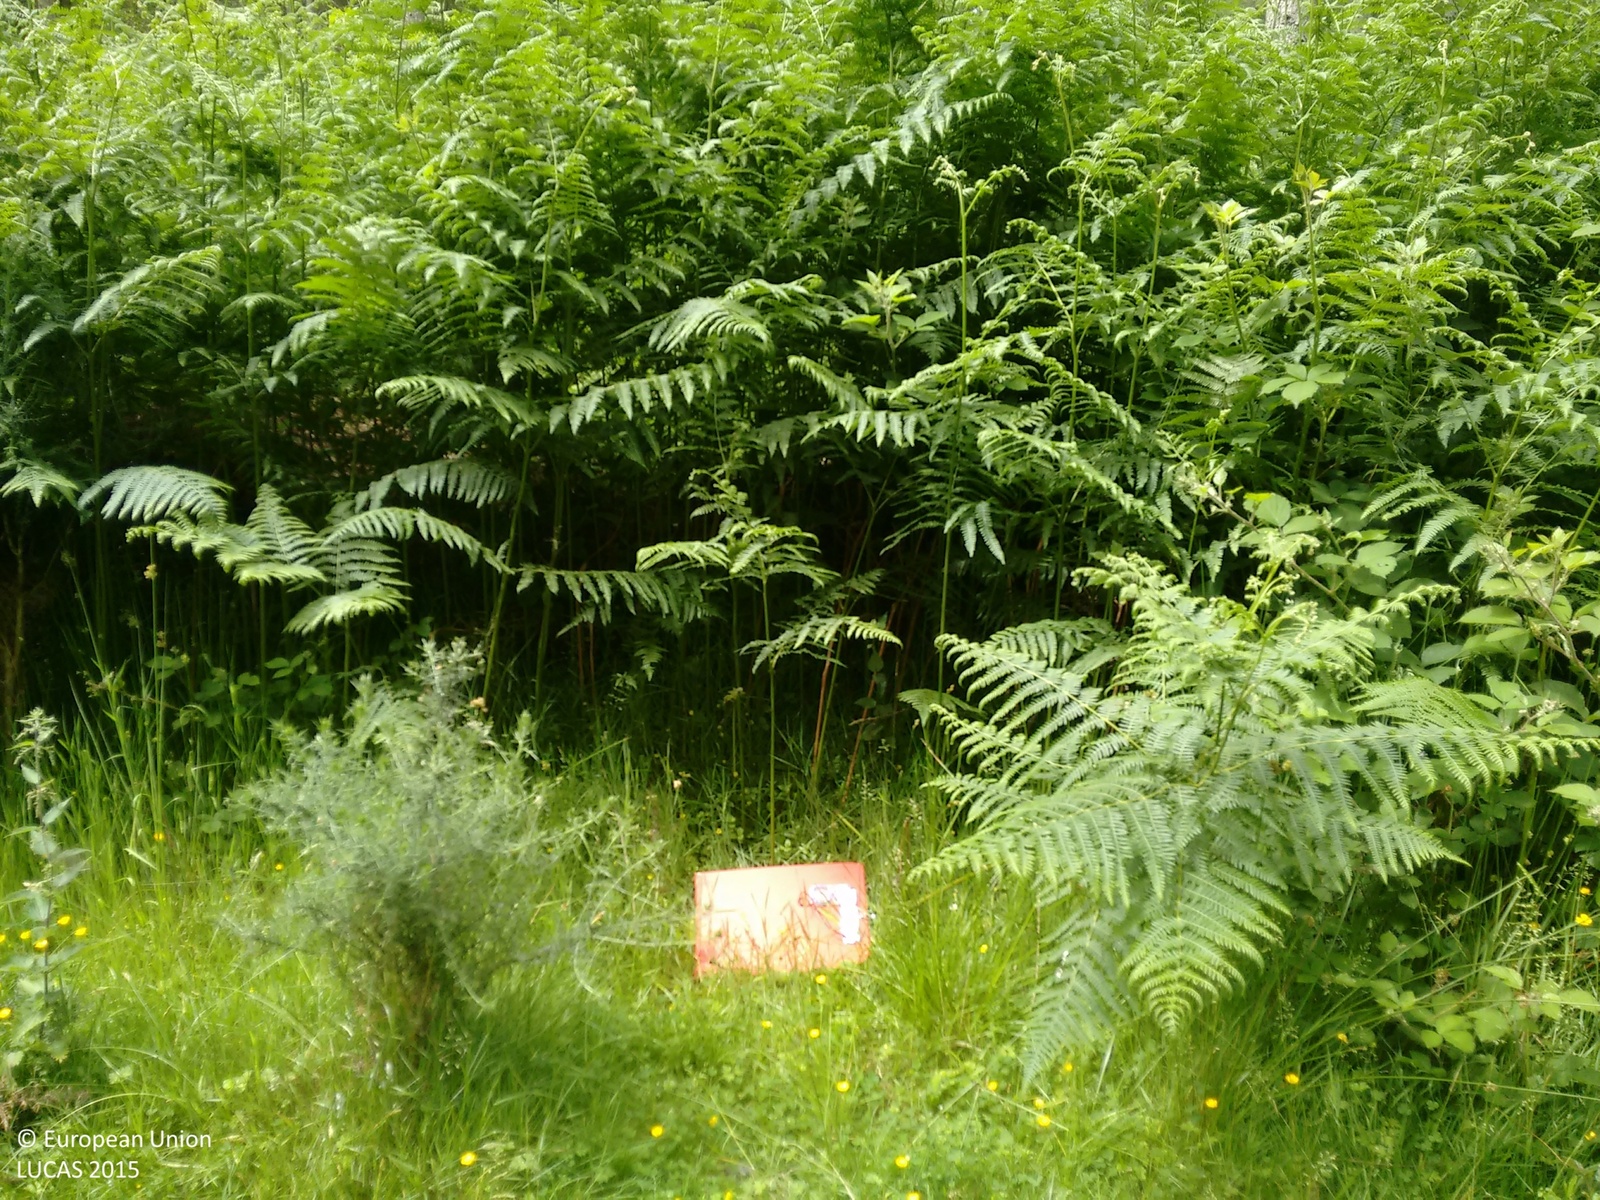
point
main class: Woodland
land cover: Spruce dominated coniferous woodland
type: exotic forest
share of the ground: > 75 %
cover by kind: coniferous forest trees 95 %, shrubs 5 %
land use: Forestry
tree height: > 5 m
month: June
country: GB
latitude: 52.3017
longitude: -2.7856
